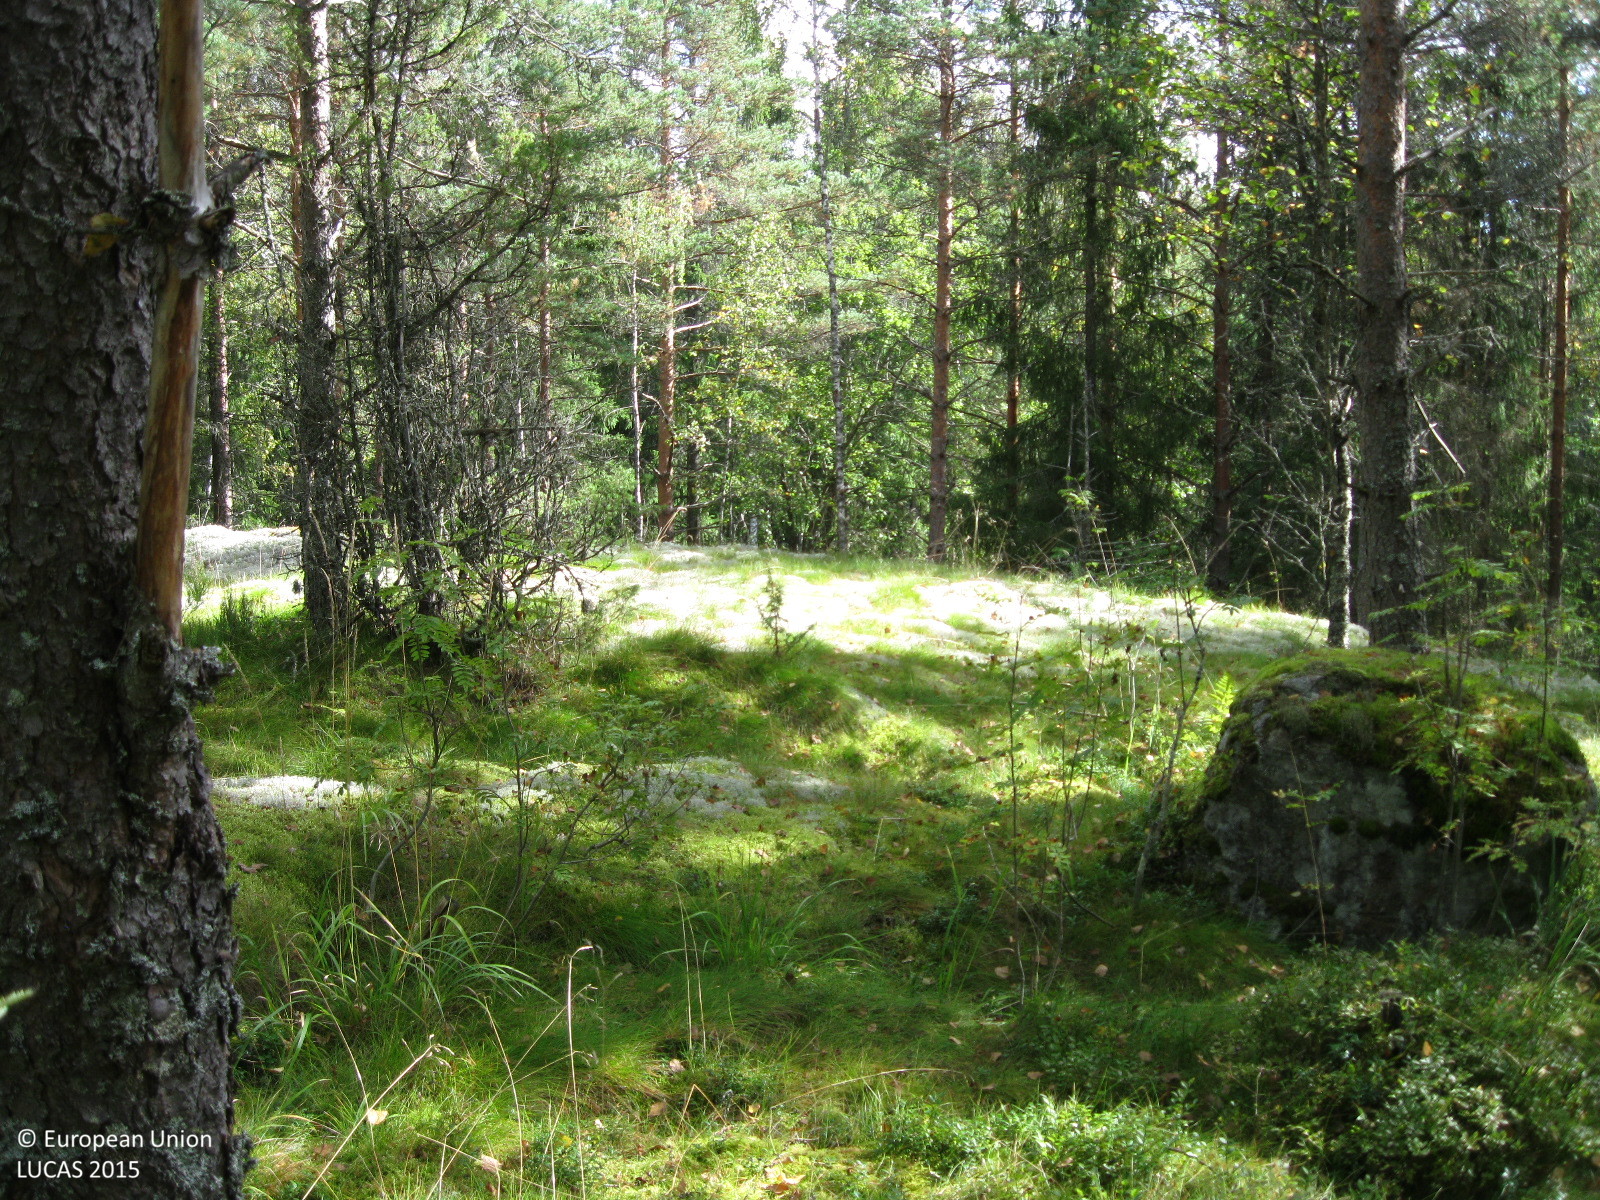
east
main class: Woodland
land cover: Other mixed woodland
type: boreal forest
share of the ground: > 75 %
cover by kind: coniferous forest trees 55 %, broadleaved forest trees 20 %, shrubs 10 %, lichens and mosses 10 %, herbaceous plants 5 %
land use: Forestry
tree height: > 5 m
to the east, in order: Other mixed woodland; Ditches and canals; Grass margins; Tracks; Grass margins; Spruce dominated mixed woodland
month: September
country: FI
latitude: 60.4124
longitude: 24.5423
